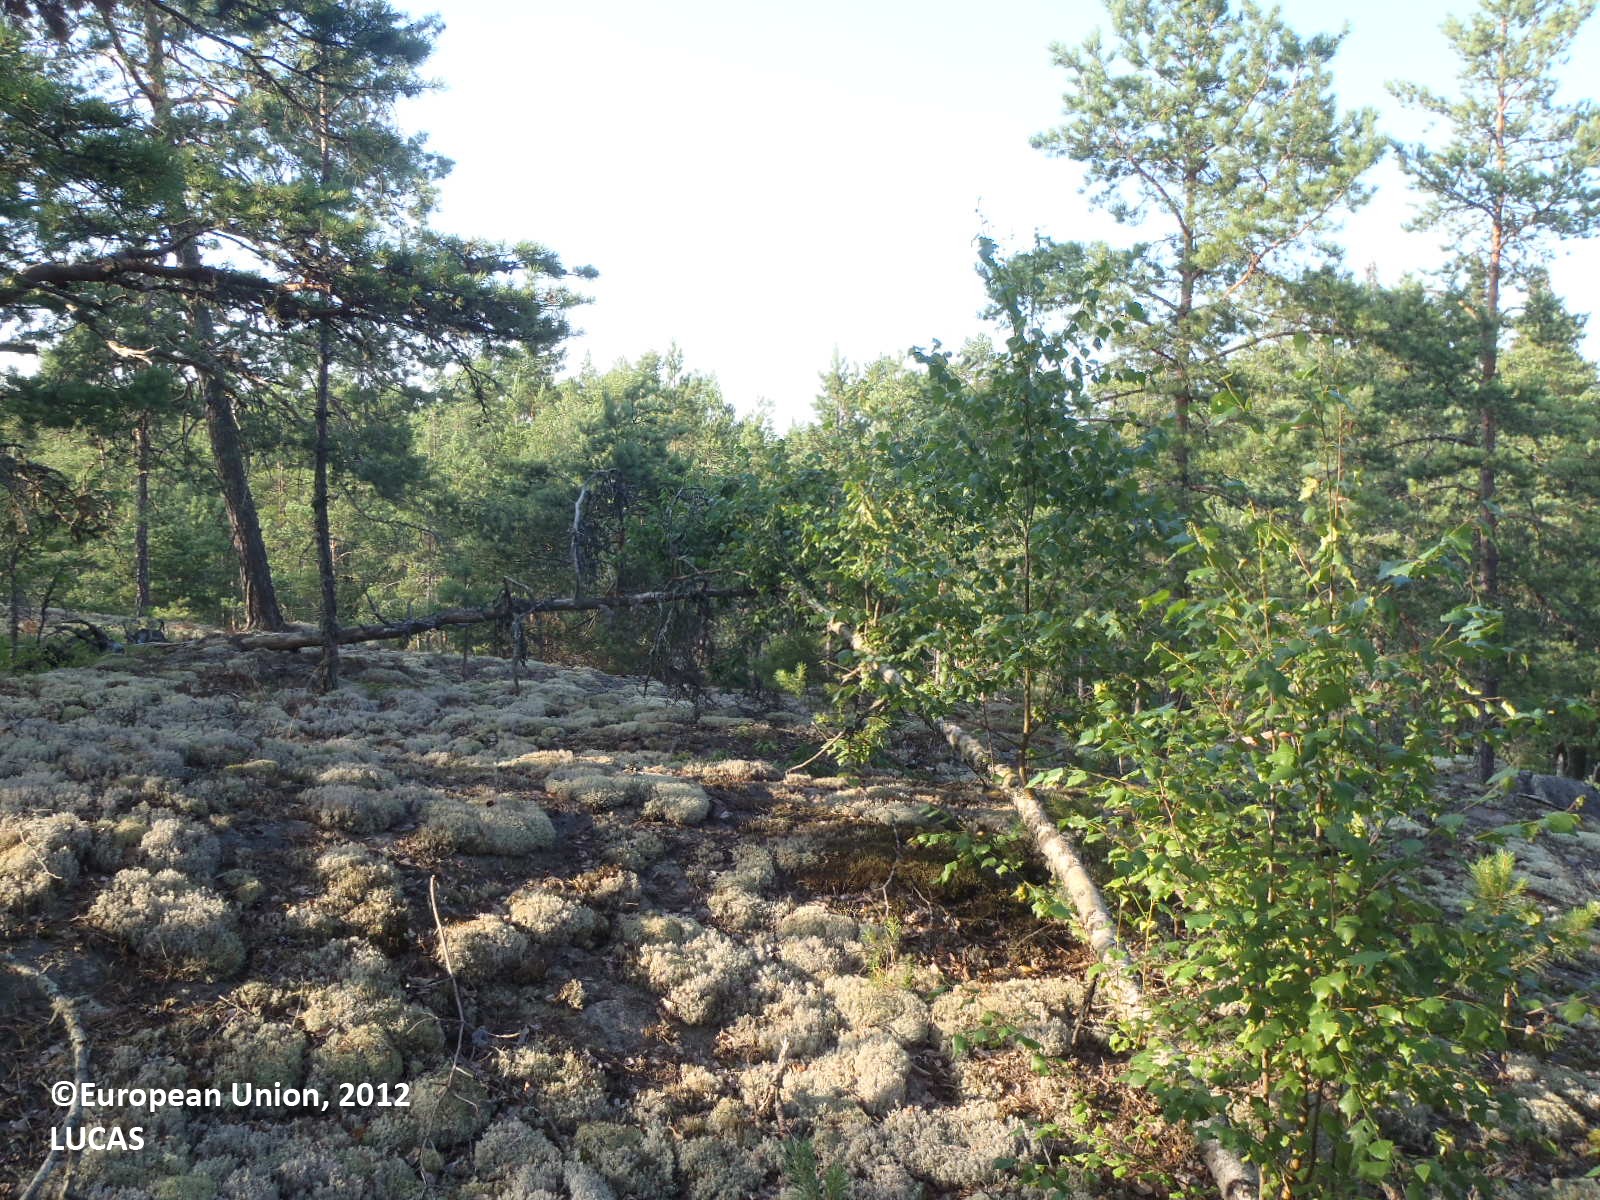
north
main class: Woodland
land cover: Pine dominated coniferous woodland
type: boreal forest
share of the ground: 50 - 75 %
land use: Semi-natural and natural areas not in use
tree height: > 5 m
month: July
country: FI
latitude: 60.5509
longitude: 21.6737
